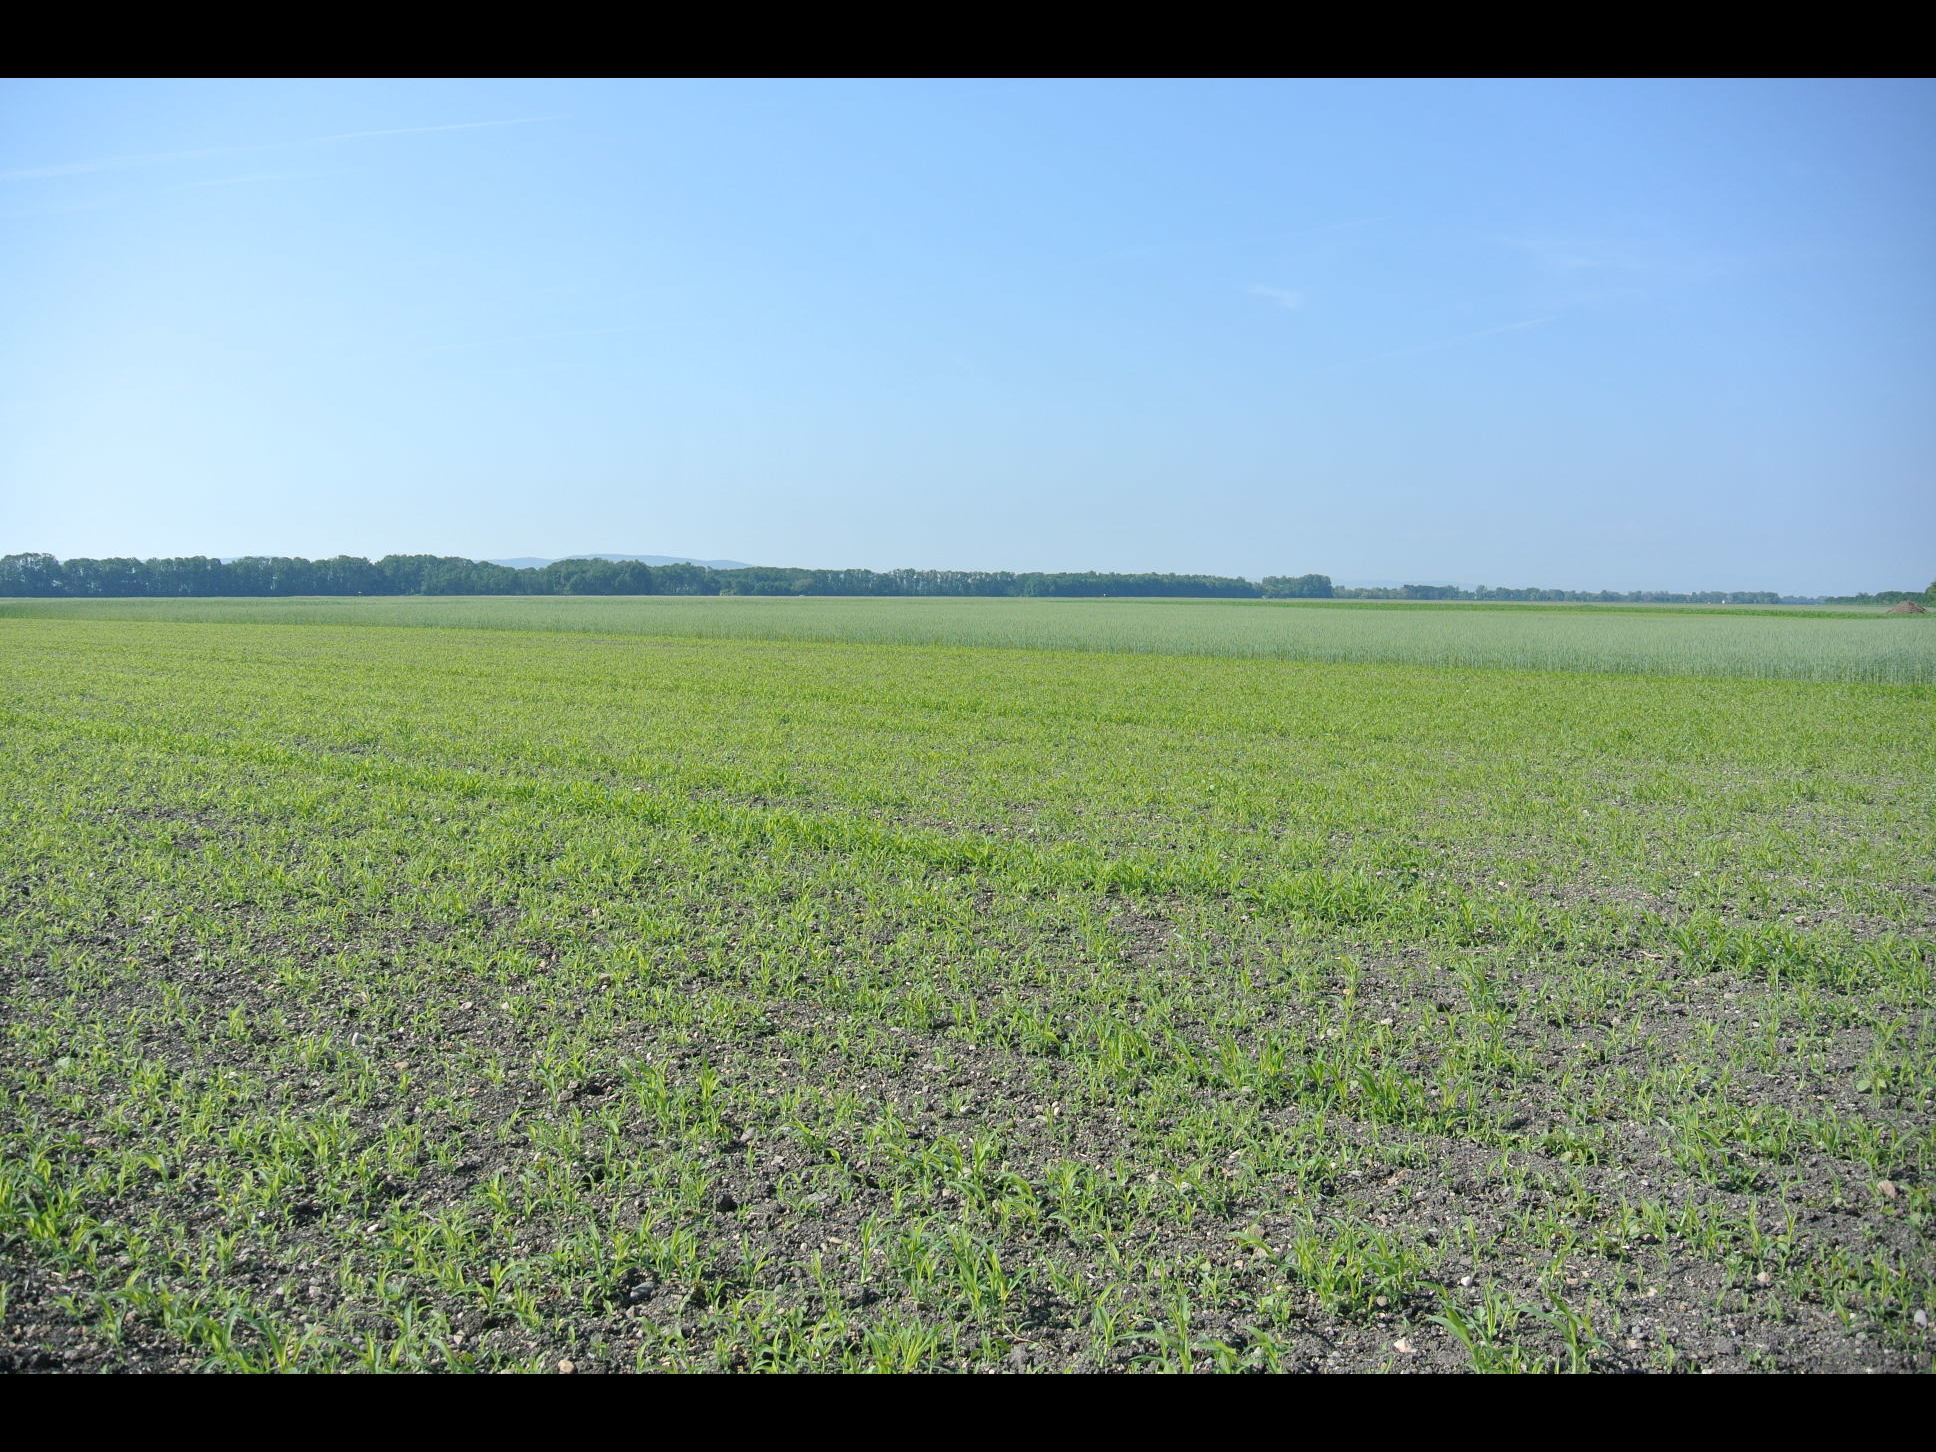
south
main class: Cropland
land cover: Maize
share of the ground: > 75 %
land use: Agriculture (excluding fallow land and kitchen gardens)
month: May
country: AT
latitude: 47.9790
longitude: 16.4757
